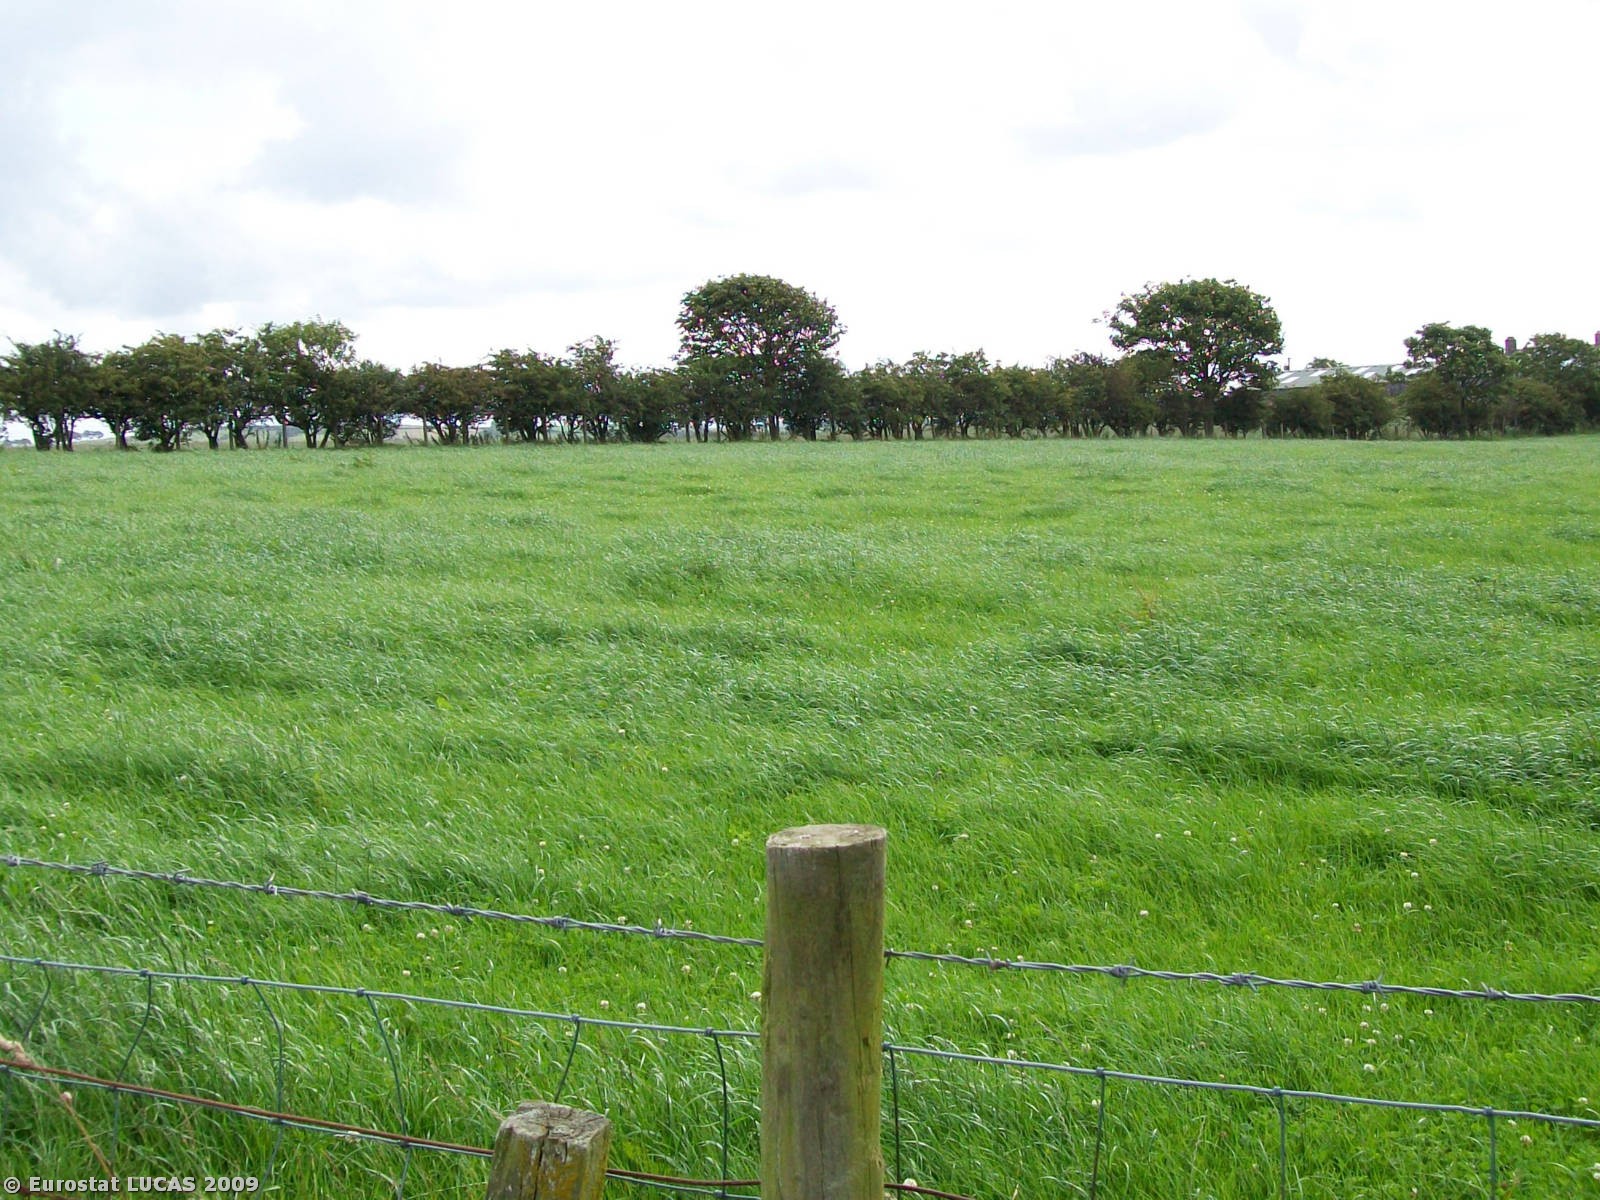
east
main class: Grassland
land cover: Grassland without tree/shrub cover
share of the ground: > 75 %
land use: Agriculture (excluding fallow land and kitchen gardens)
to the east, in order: Grassland without tree/shrub cover; Abandoned hedges; Fences; Grassland without tree/shrub cover; Fences; Abandoned hedges; Grassland without tree/shrub cover
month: July
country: GB
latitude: 55.0705
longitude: -3.3099
